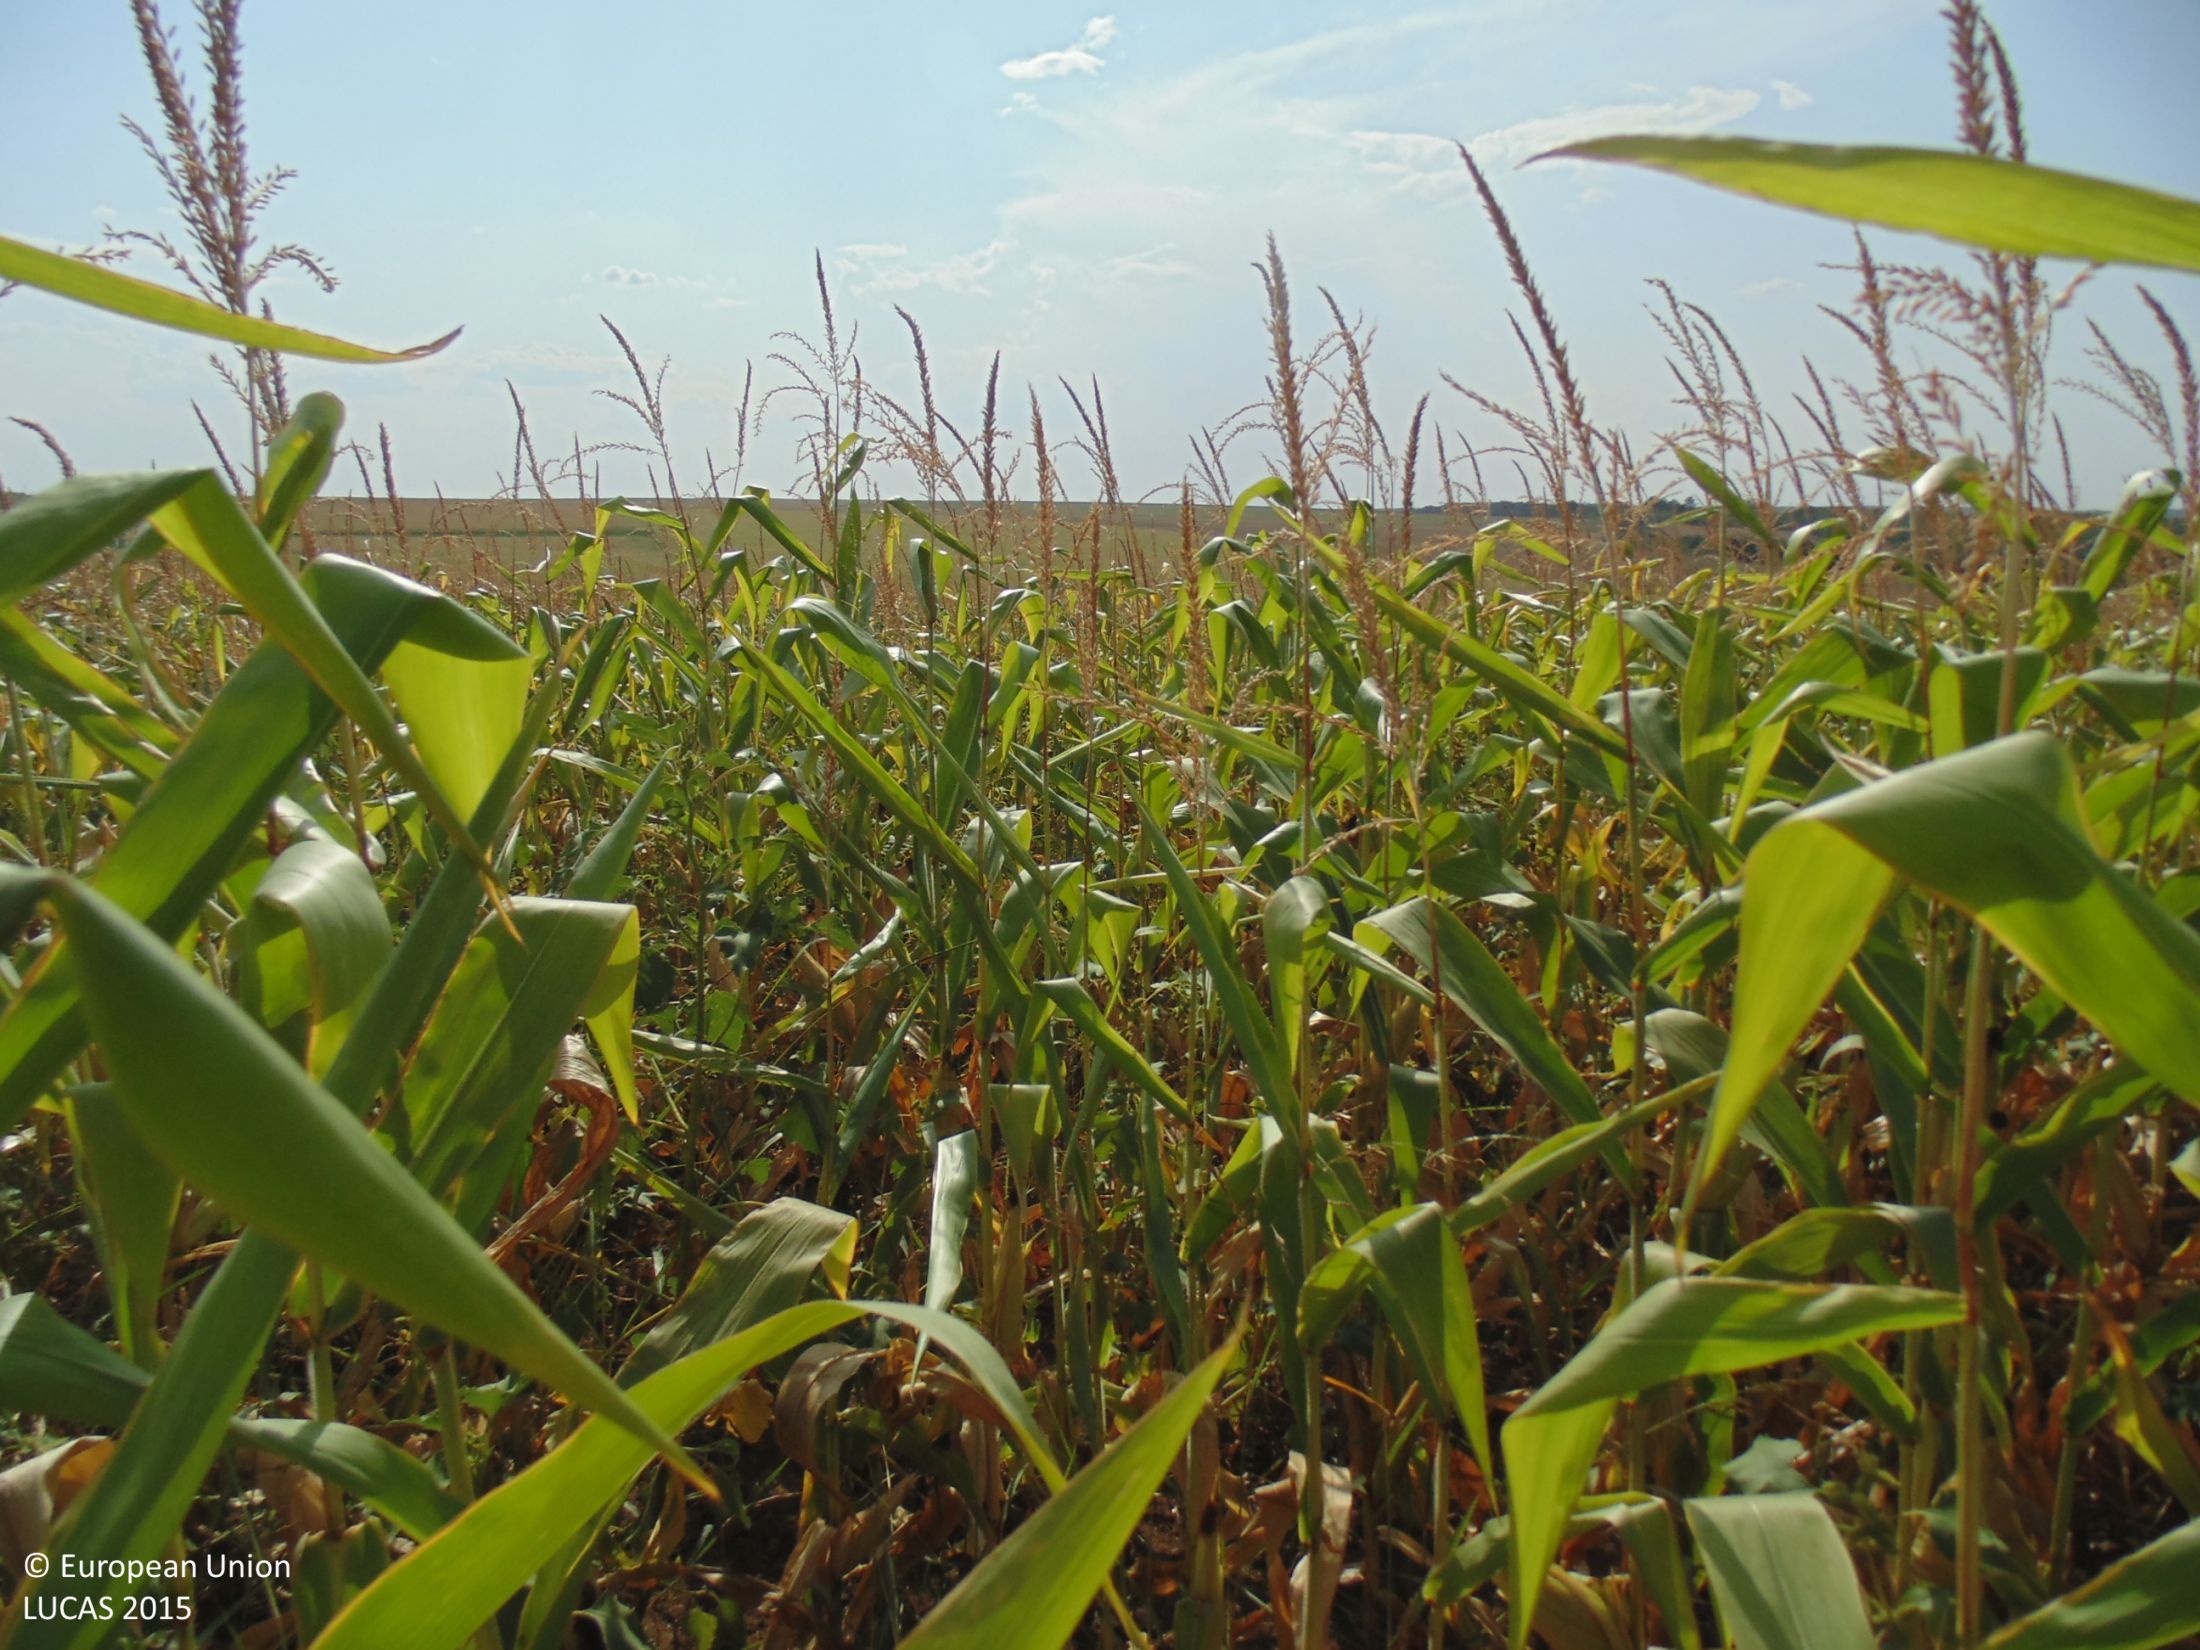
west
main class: Cropland
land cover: Maize
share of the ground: > 75 %
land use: Agriculture (excluding fallow land and kitchen gardens)
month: August
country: BG
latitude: 43.8379
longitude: 27.5357
